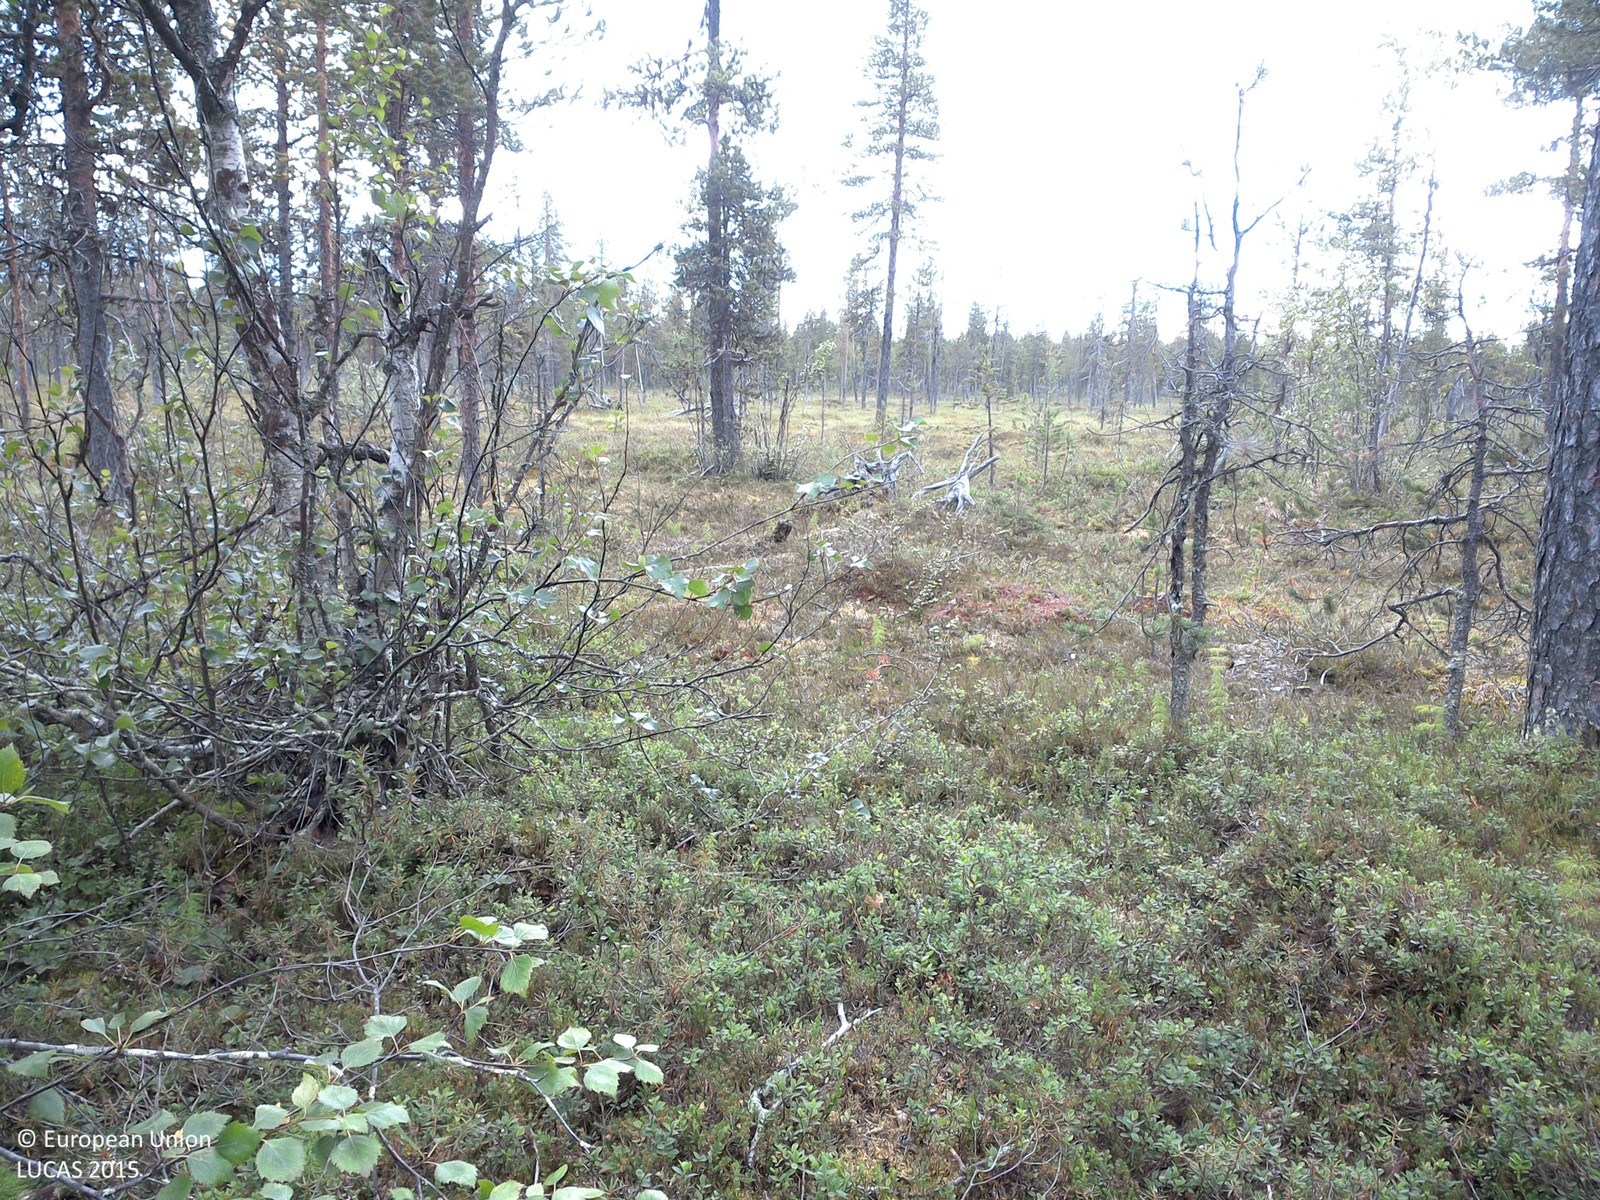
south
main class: Woodland
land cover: Pine dominated mixed woodland
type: boreal forest
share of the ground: 25 - 50 %
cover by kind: shrubs 60 %, coniferous forest trees 15 %, lichens and mosses 15 %, broadleaved forest trees 10 %
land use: Forestry
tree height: > 5 m
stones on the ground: < 10 %
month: August
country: SE
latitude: 67.4762
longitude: 21.5296
